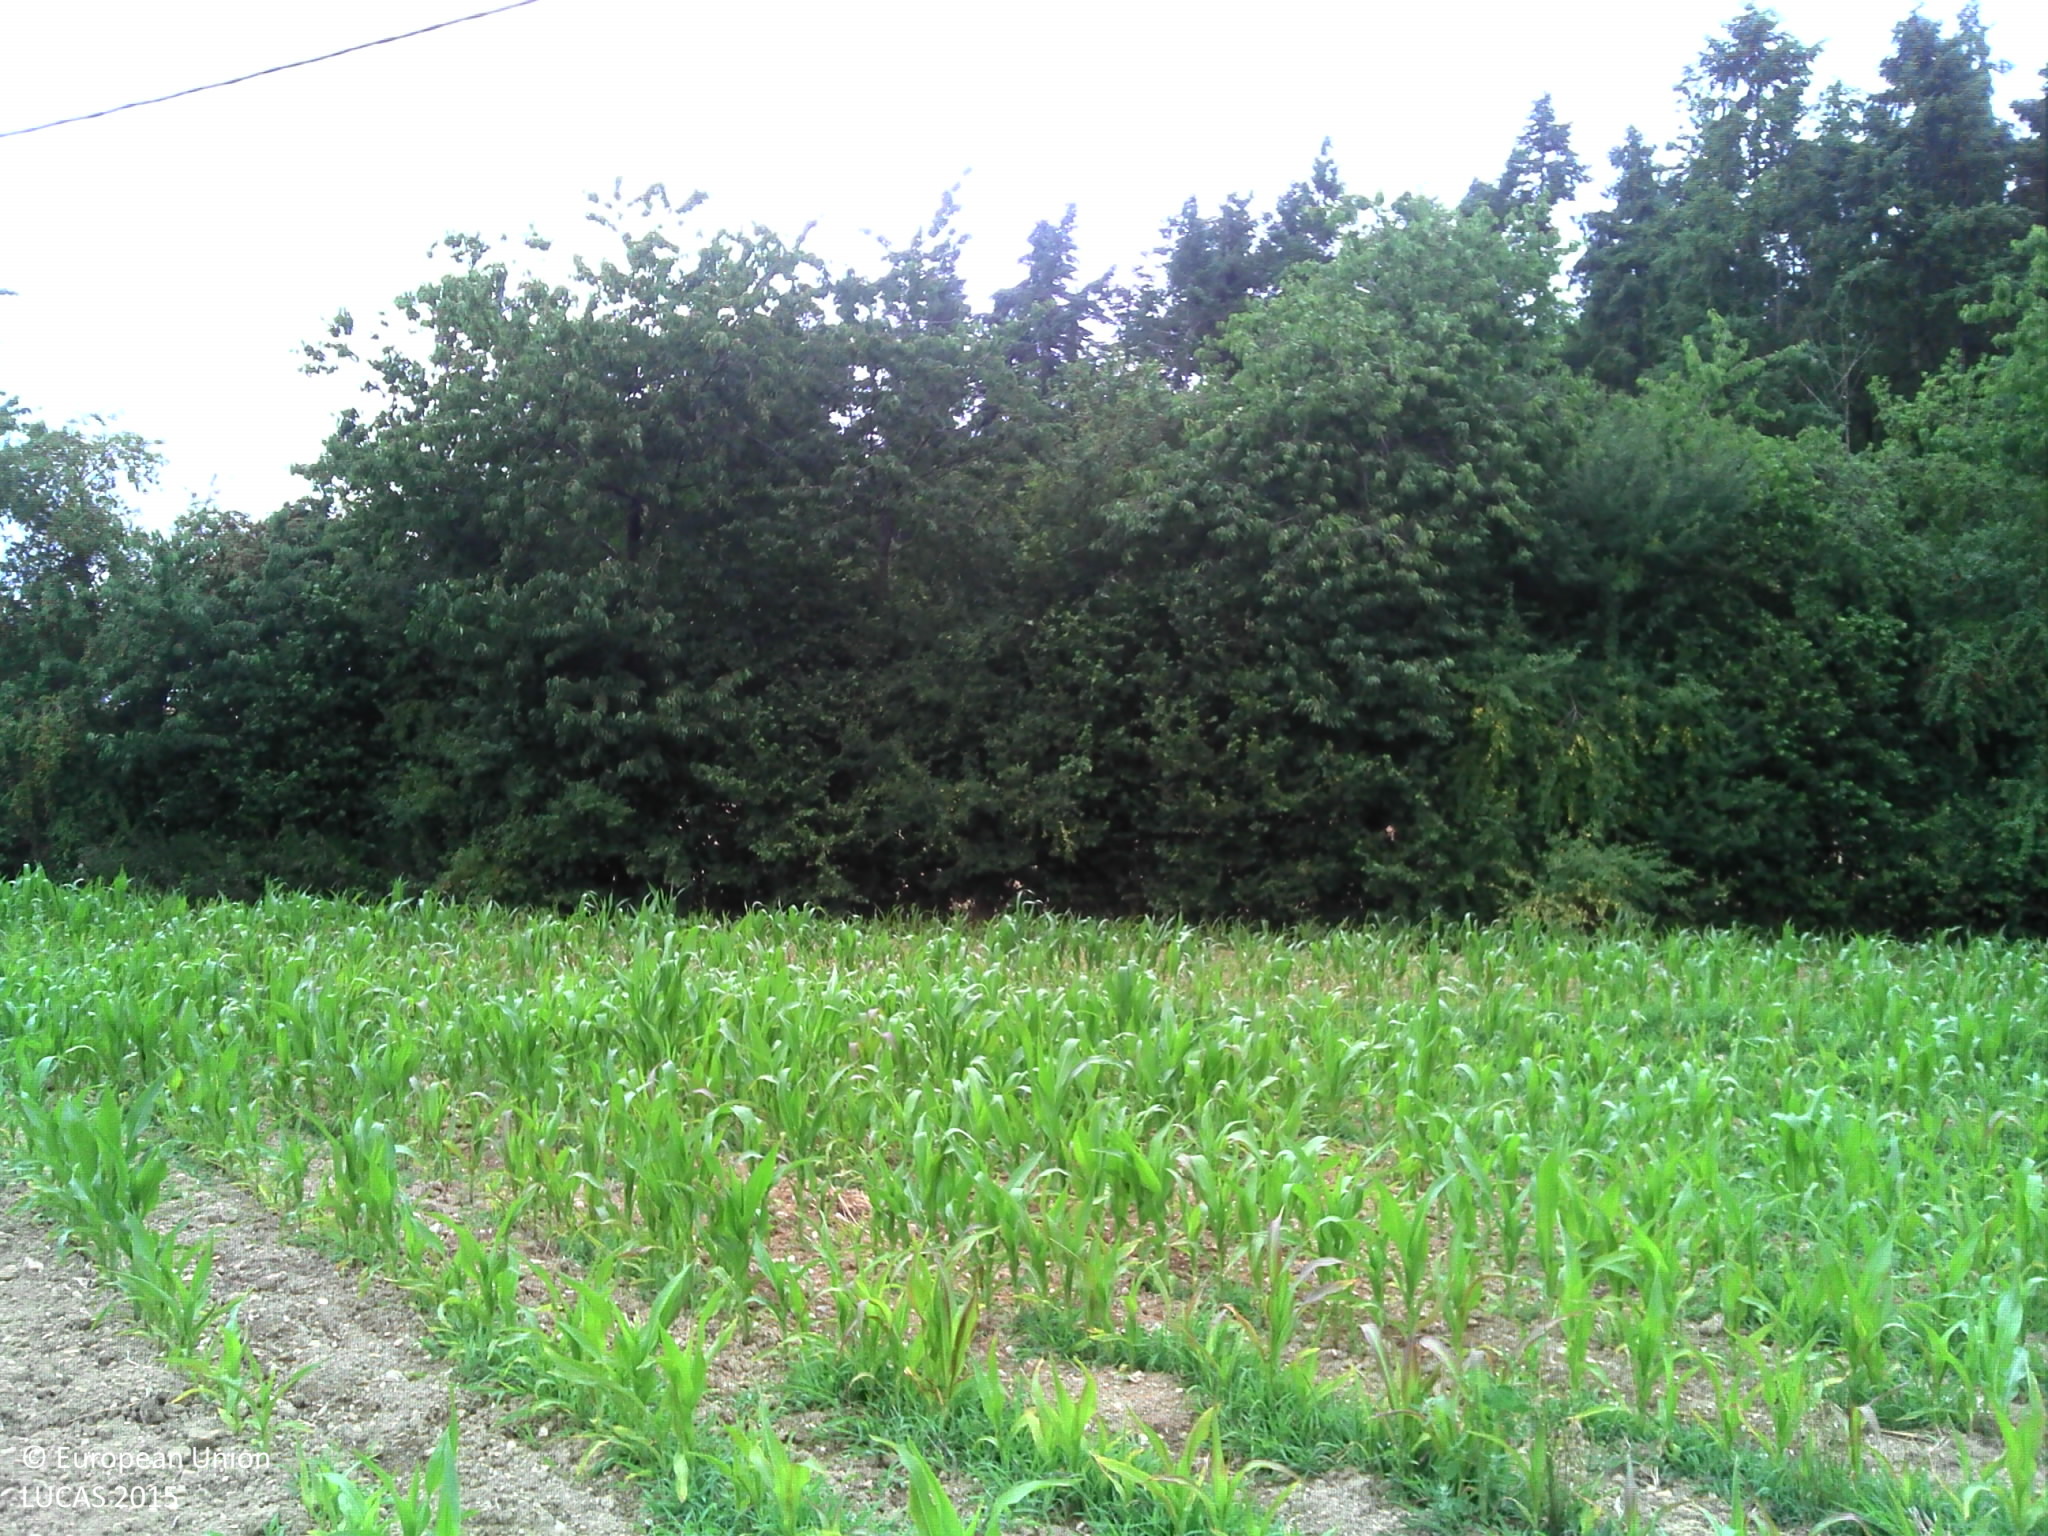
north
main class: Cropland
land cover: Maize
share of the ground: 10 - 25 %
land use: Agriculture (excluding fallow land and kitchen gardens)
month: July
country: FR
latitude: 47.8372
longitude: -2.0092
